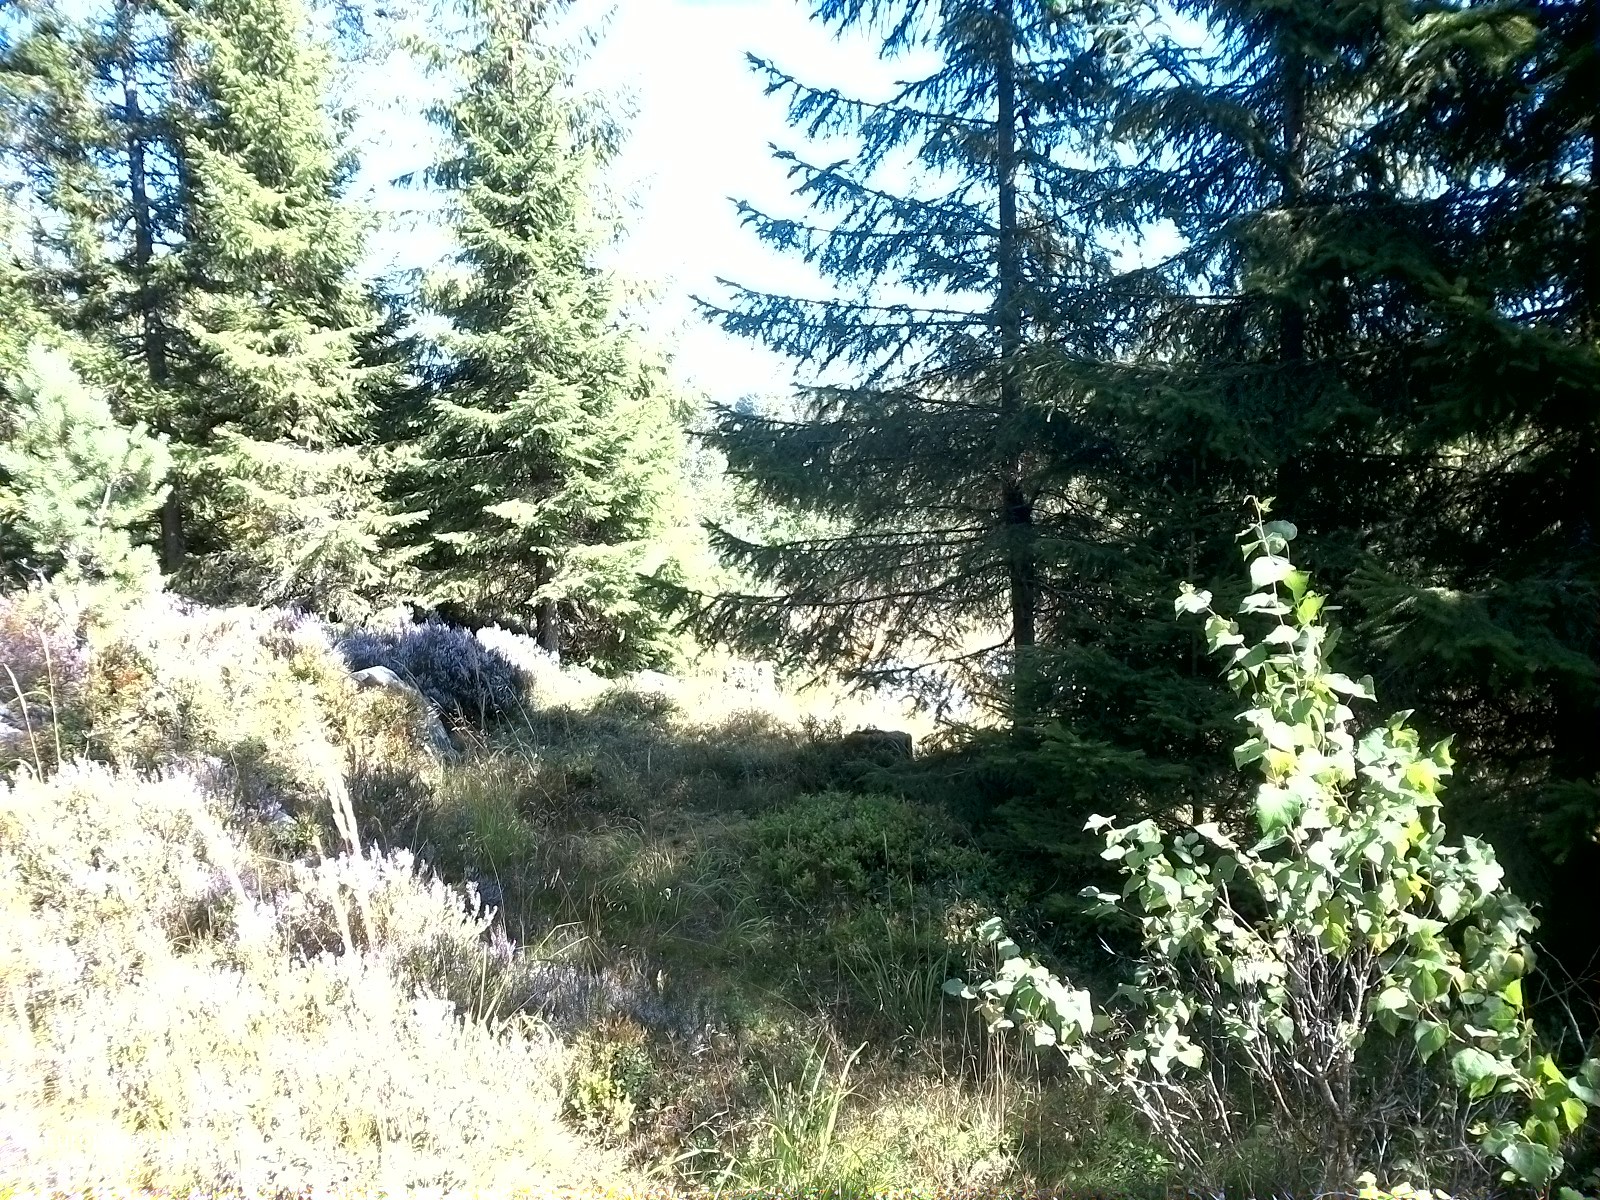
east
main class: Woodland
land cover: Spruce dominated mixed woodland
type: boreal forest
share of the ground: 25 - 50 %
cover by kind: herbaceous plants 30 %, shrubs 25 %, coniferous forest trees 20 %, broadleaved forest trees 15 %, lichens and mosses 10 %
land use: Forestry
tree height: < 5 m
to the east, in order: Spruce dominated mixed woodland; Other mixed woodland; Pine dominated mixed woodland; Other mixed woodland; Tracks; Other mixed woodland; Other coniferous woodland
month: August
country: SE
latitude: 59.4037
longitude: 15.0817
